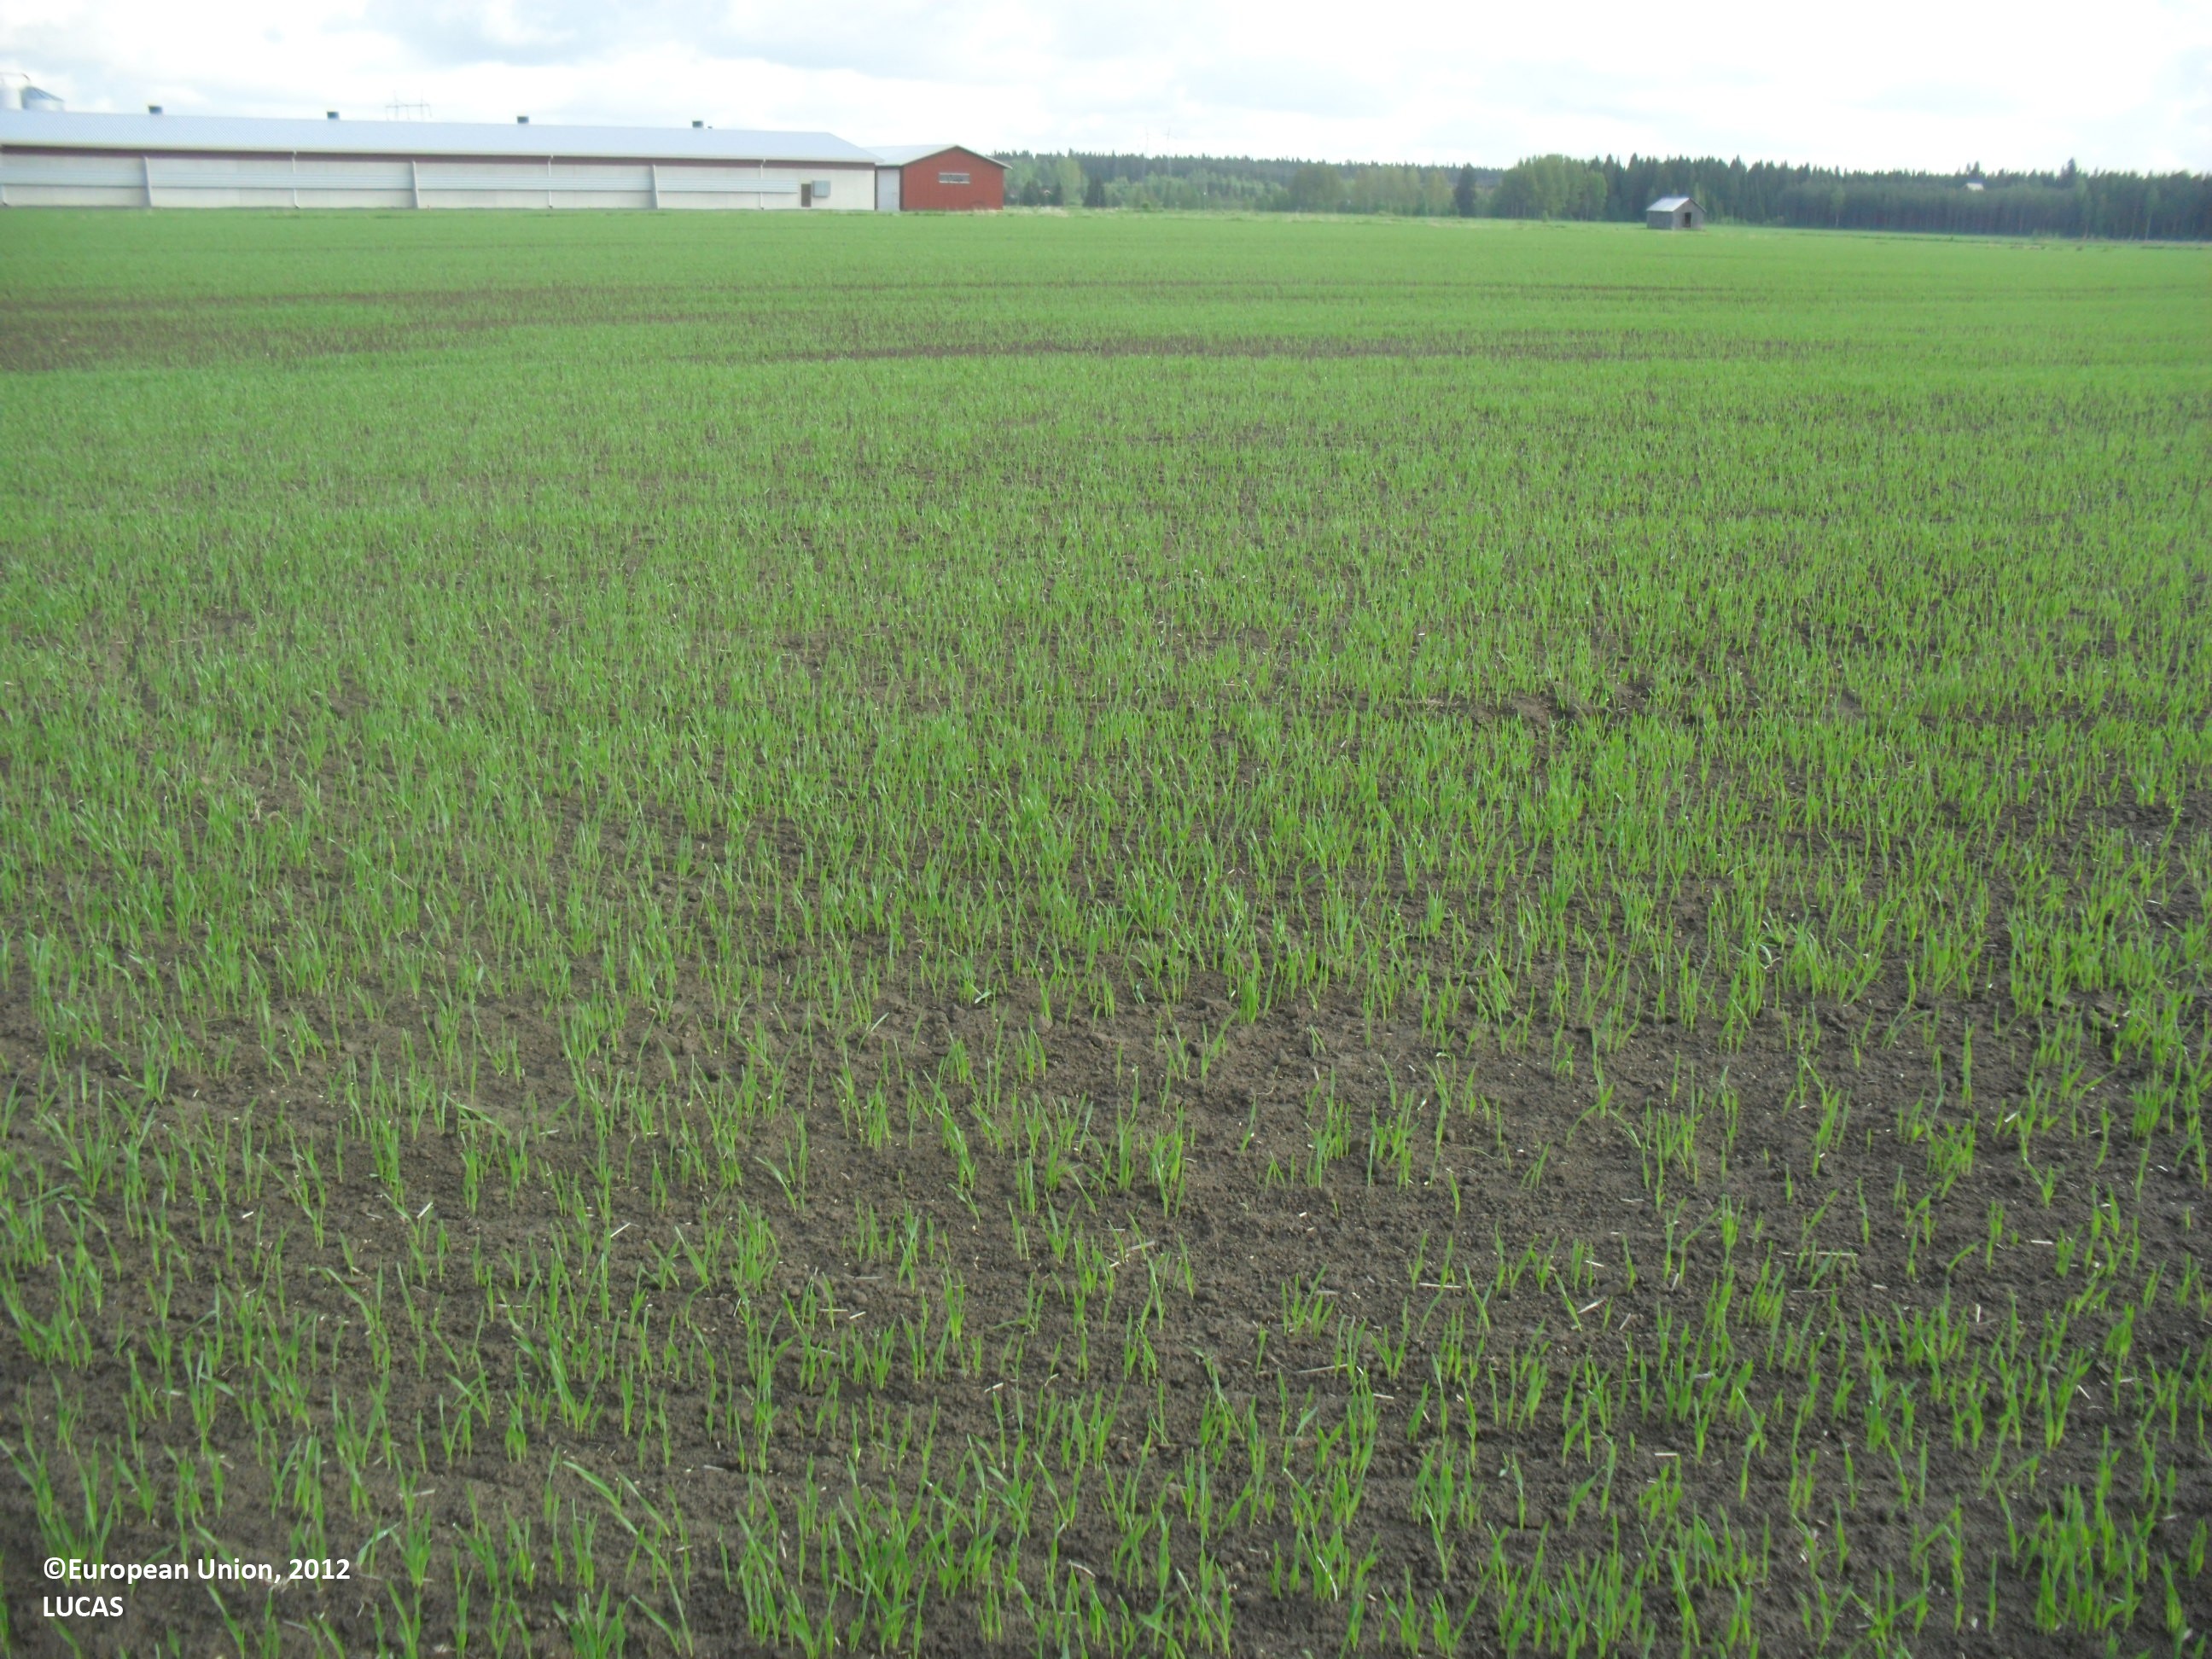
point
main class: Cropland
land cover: Barley
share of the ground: < 10 %
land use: Agriculture (excluding fallow land and kitchen gardens)
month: June
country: FI
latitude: 62.8196
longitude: 22.9517
